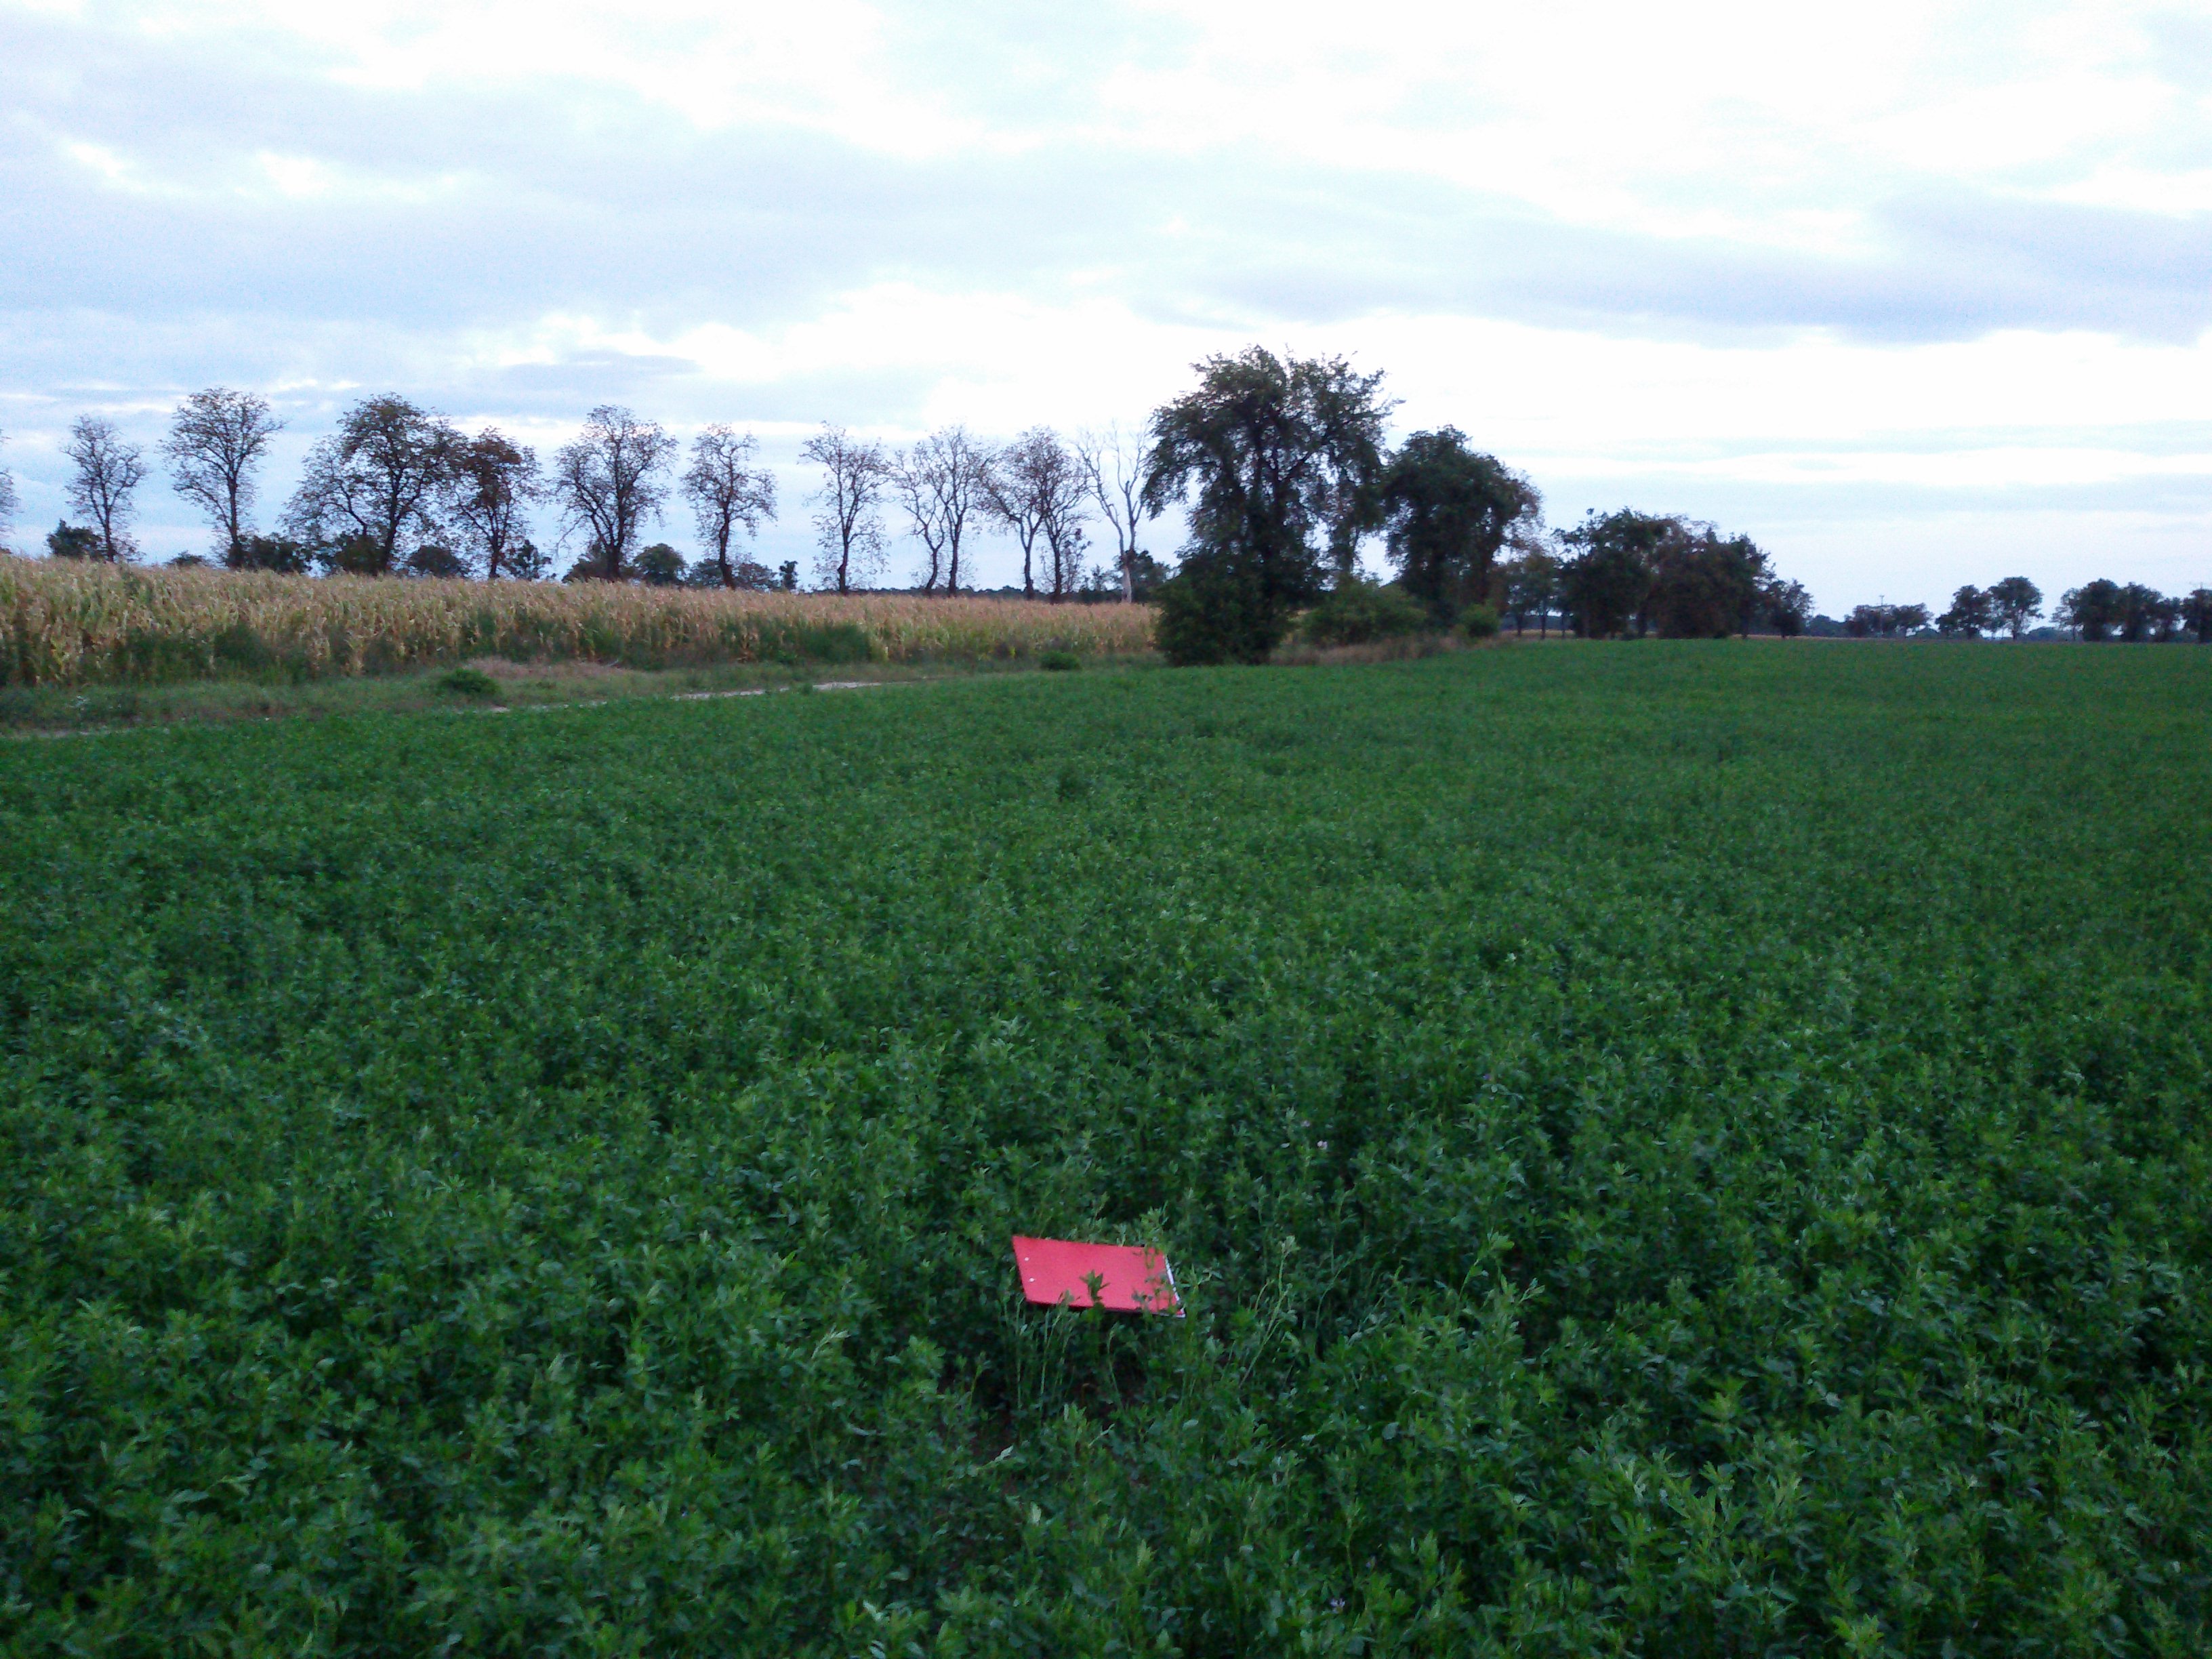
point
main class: Cropland
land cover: Lucerne
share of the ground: > 75 %
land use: Agriculture (excluding fallow land and kitchen gardens)
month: September
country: PL
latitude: 53.0147
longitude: 17.6597
